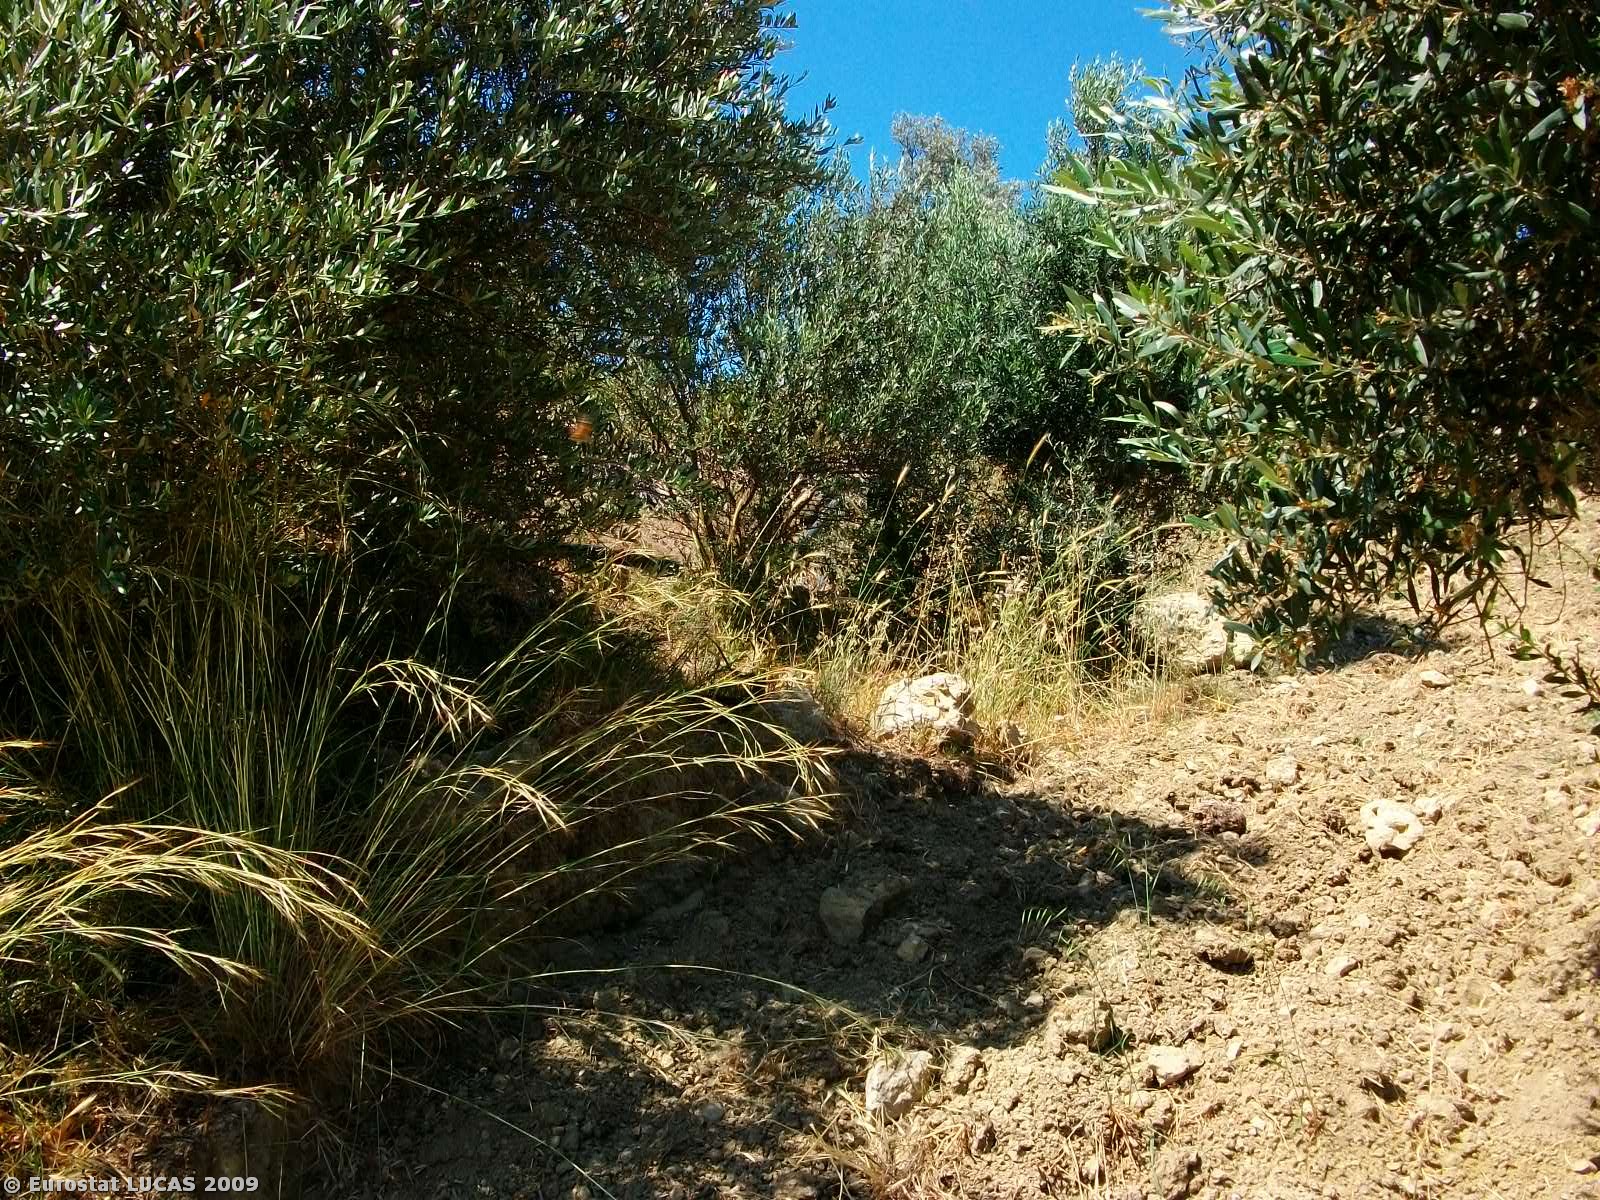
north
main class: Cropland
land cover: Olive groves
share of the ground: 50 - 75 %
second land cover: Bare land
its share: > 75 %
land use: Agriculture (excluding fallow land and kitchen gardens)
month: June
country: GR
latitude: 35.0833
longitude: 24.9574
